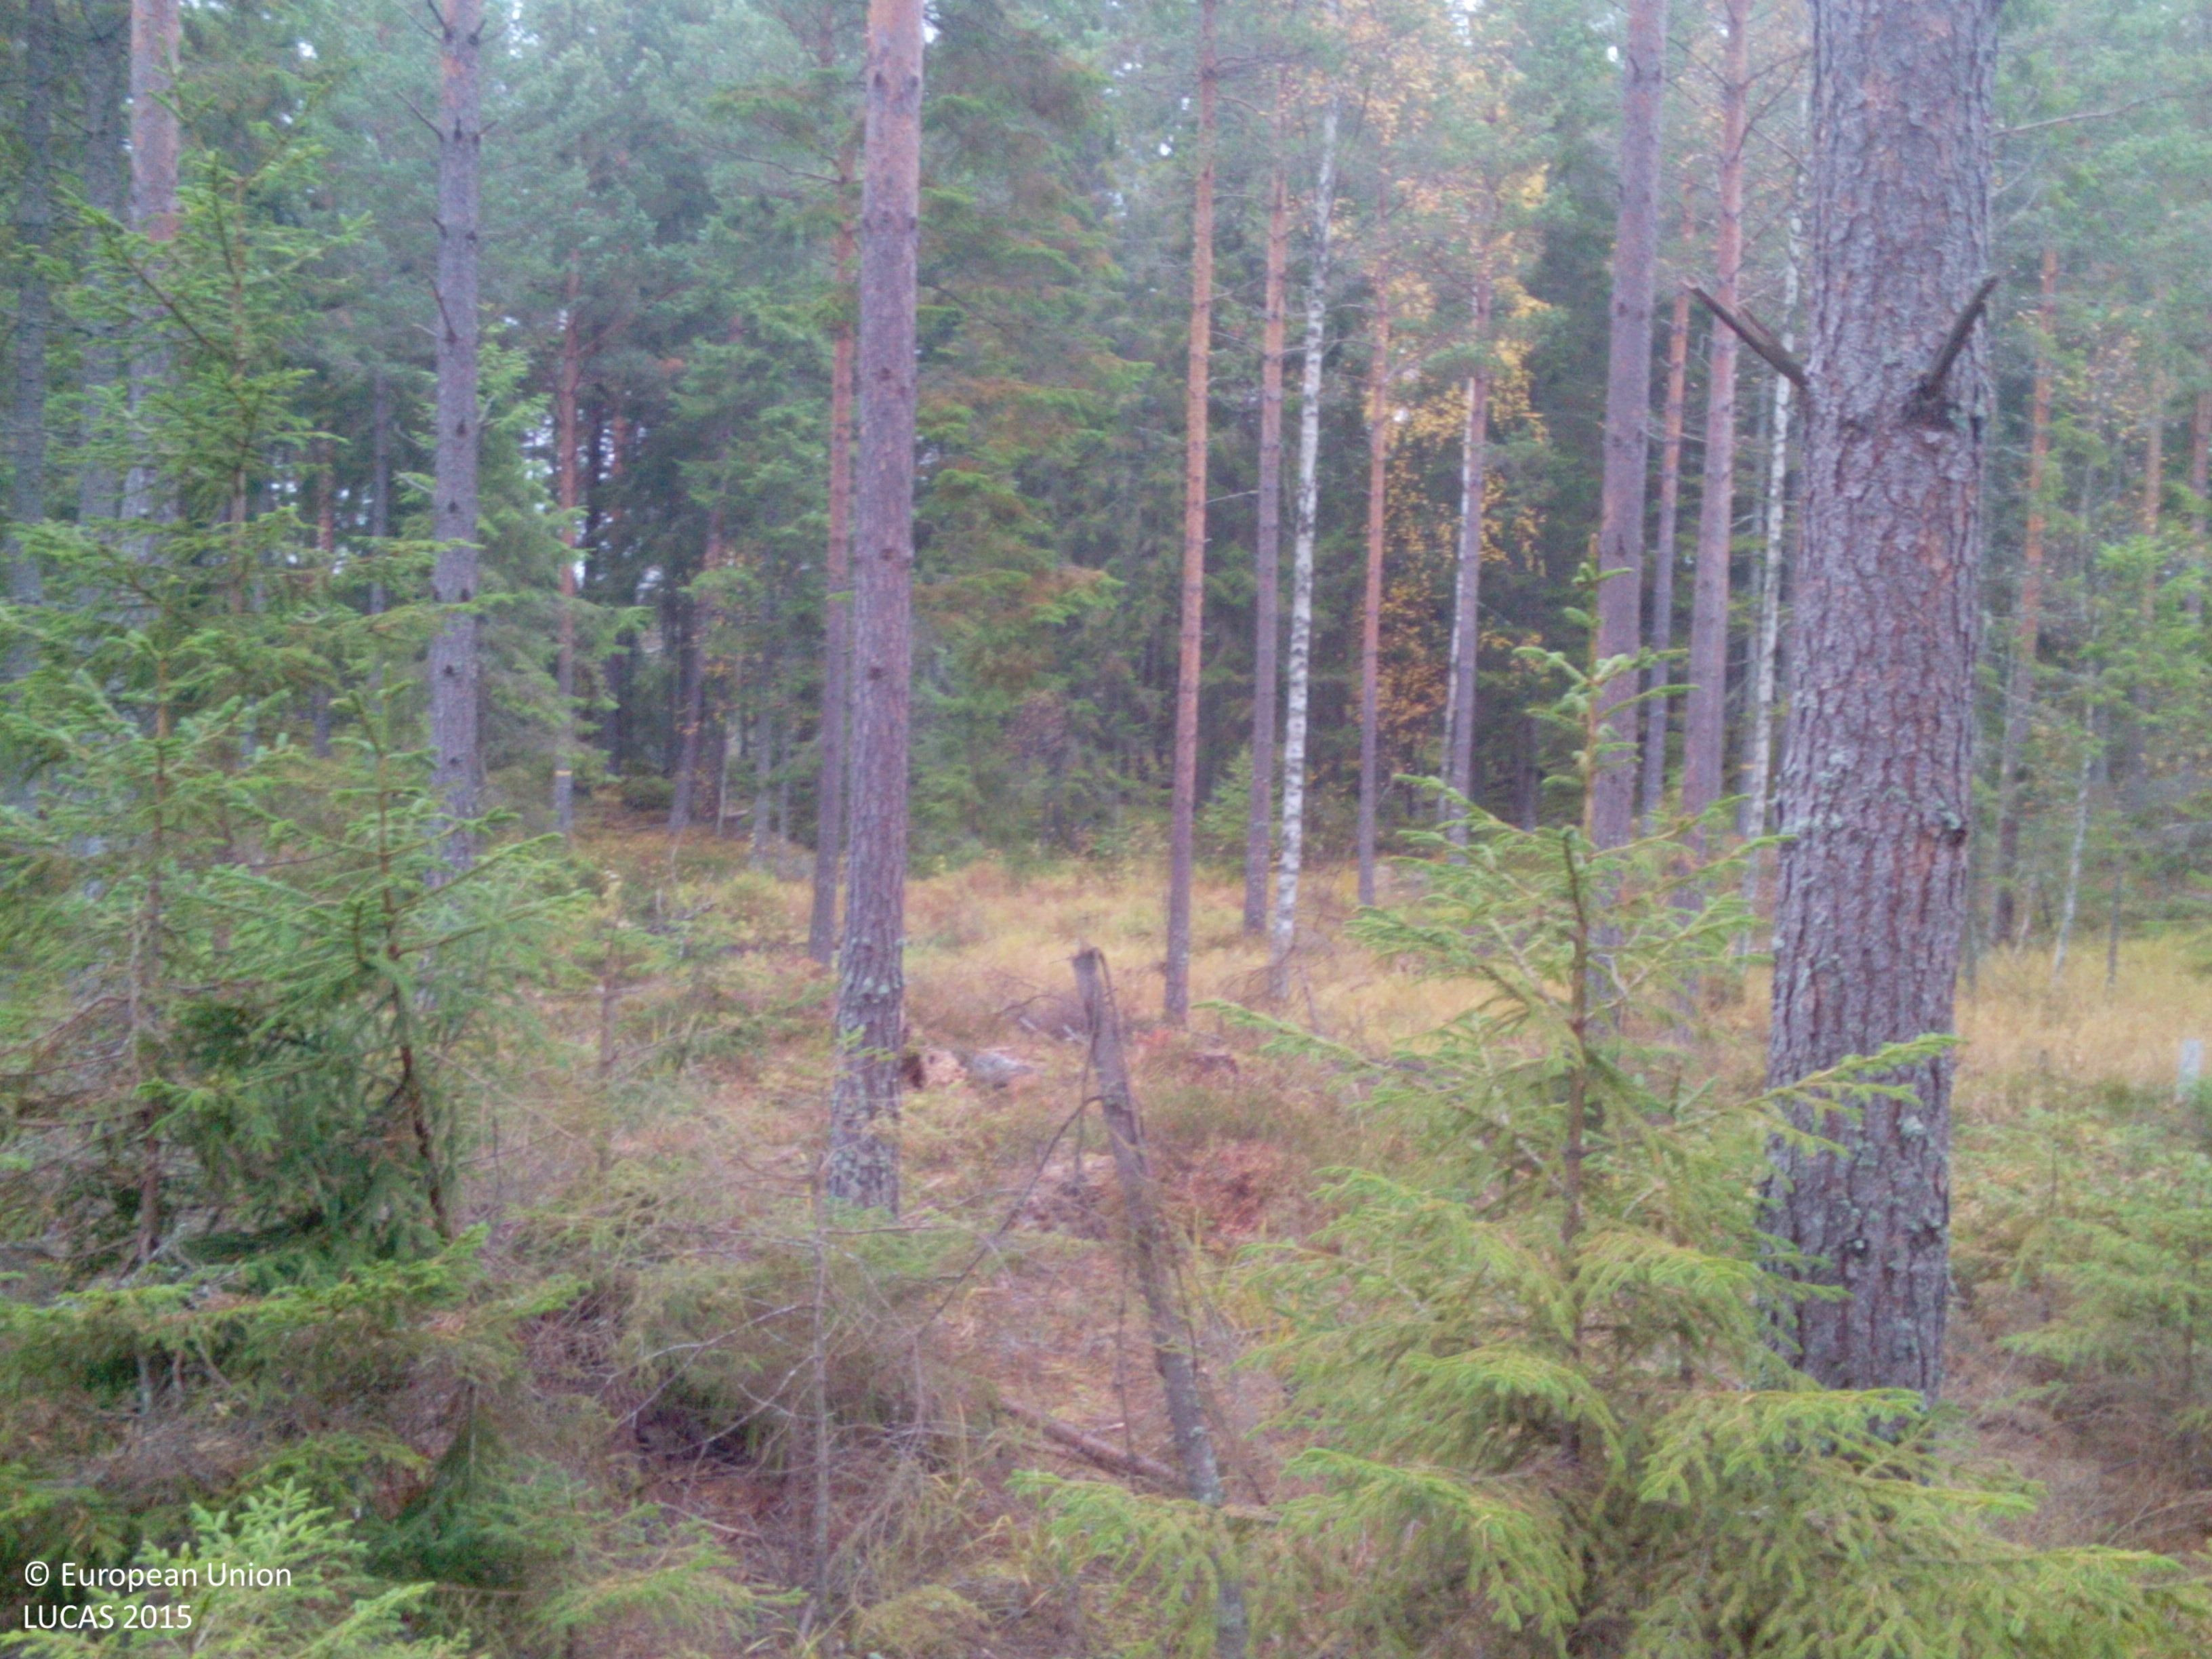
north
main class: Woodland
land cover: Other coniferous woodland
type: boreal forest
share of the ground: > 75 %
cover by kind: coniferous forest trees 85 %, lichens and mosses 10 %, herbaceous plants 5 %
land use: Forestry
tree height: > 5 m
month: October
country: SE
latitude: 59.1415
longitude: 16.1984
